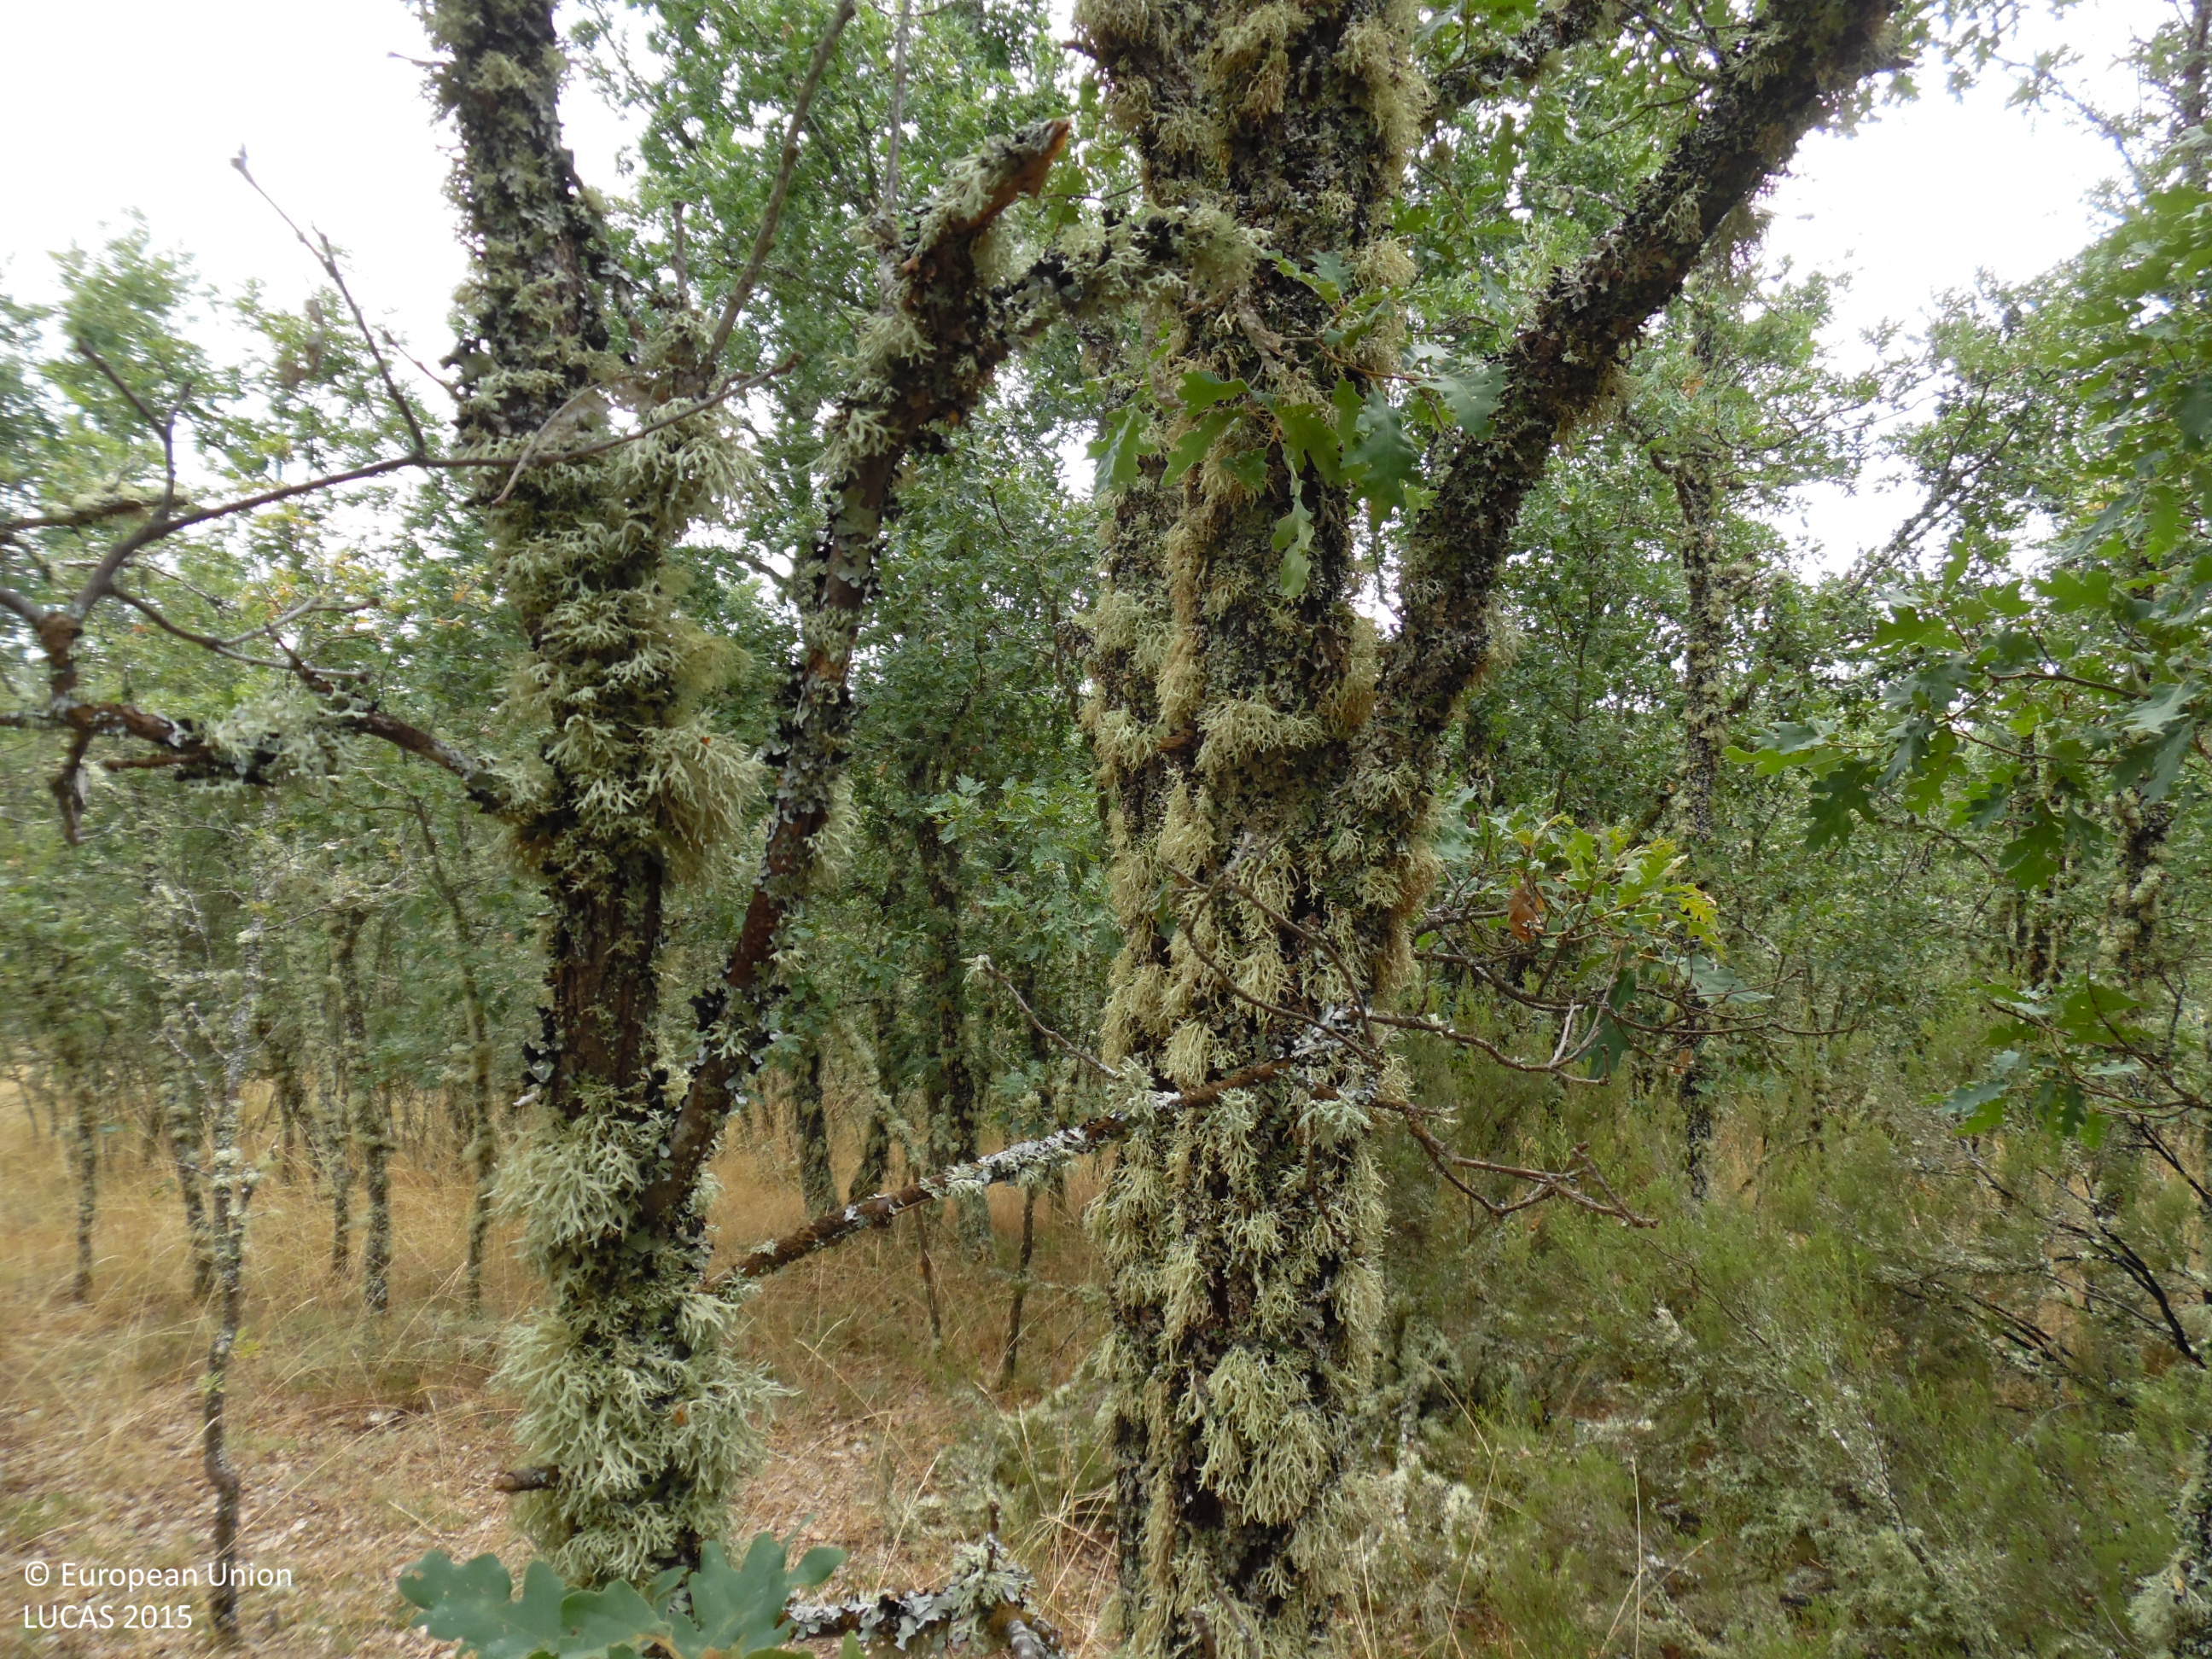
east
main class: Woodland
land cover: Broadleaved woodland
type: thermophilous deciduous forest
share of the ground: > 75 %
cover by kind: broadleaved forest trees 90 %, shrubs 5 %, herbaceous plants 5 %
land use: Forestry
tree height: > 5 m
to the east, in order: Broadleaved woodland; Grassland with sparse tree/shrub cover; Pine dominated coniferous woodland; Grassland without tree/shrub cover; Tracks; Grassland with sparse tree/shrub cover; Pine dominated coniferous woodland; Grassland with sparse tree/shrub cover; Fences; Groves; Fences; Paved roads, cycling and walking lanes; Grassland without tree/shrub cover
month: July
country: ES
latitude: 42.6608
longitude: -5.7542
